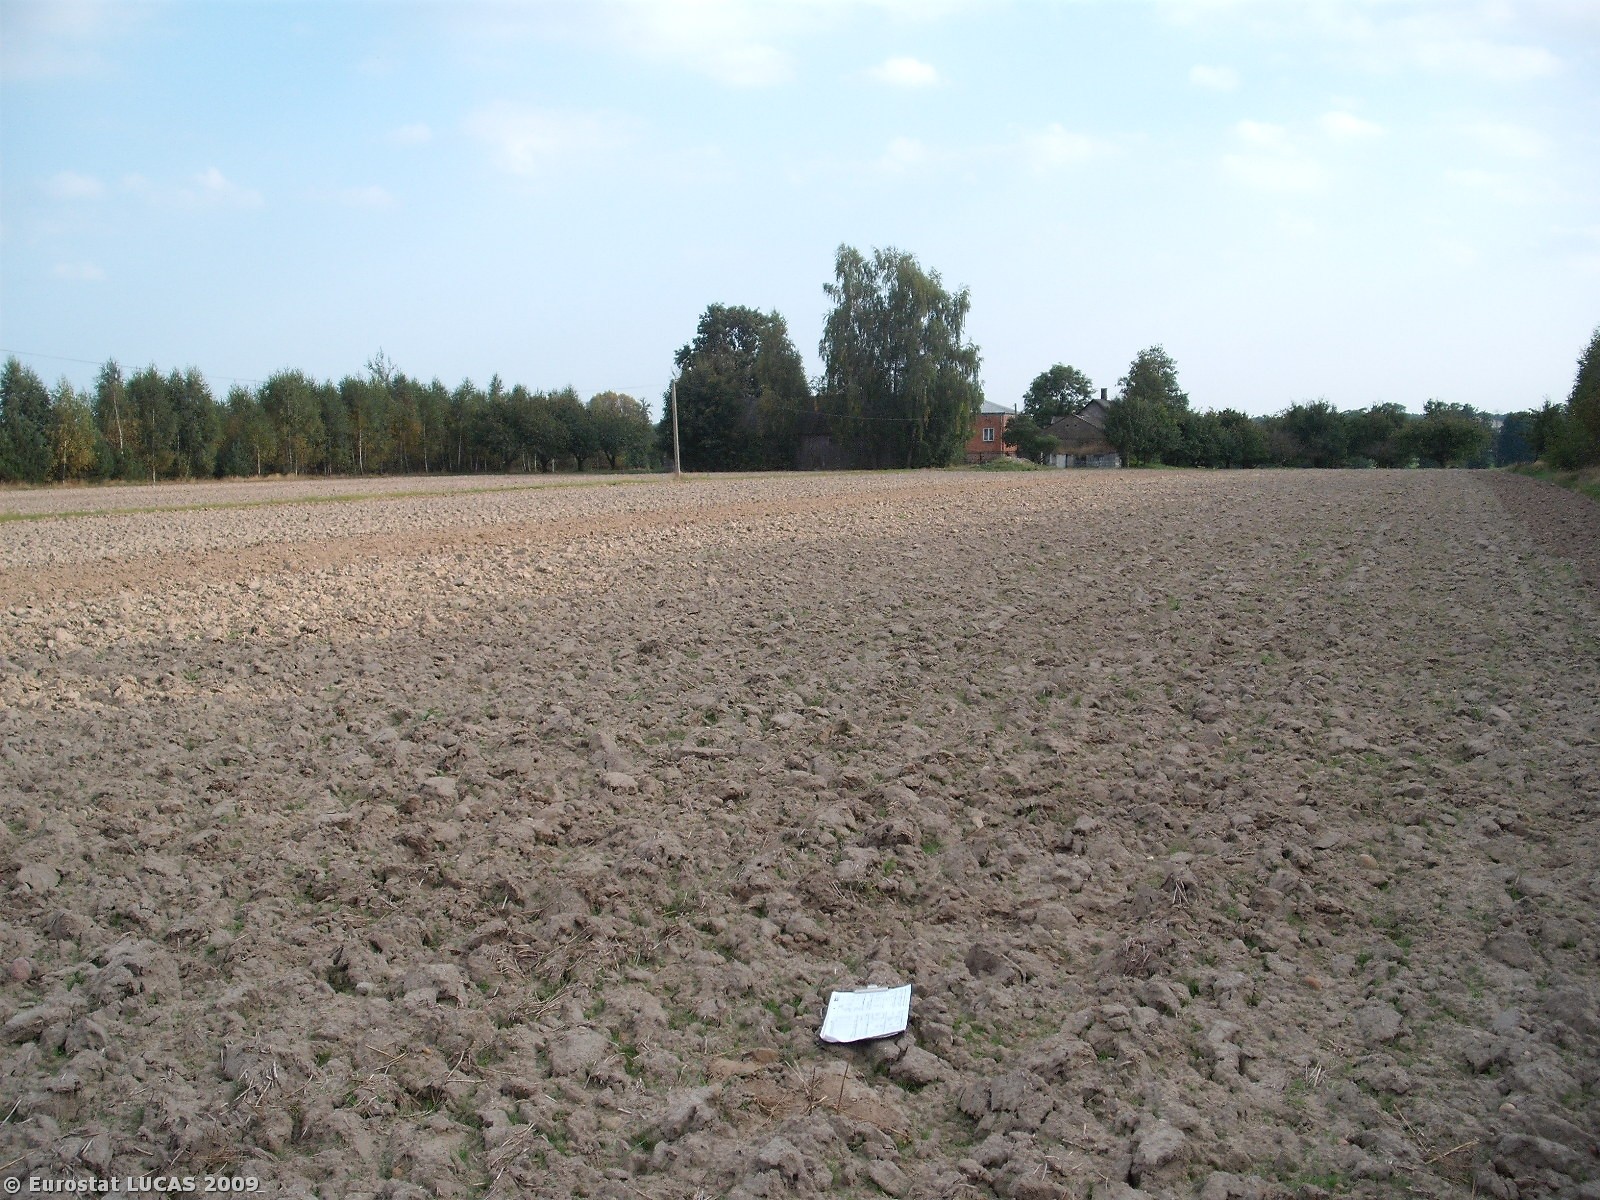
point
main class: Cropland
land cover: Rye
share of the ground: < 10 %
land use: Agriculture (excluding fallow land and kitchen gardens)
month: September
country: PL
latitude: 52.0298
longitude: 20.7839
